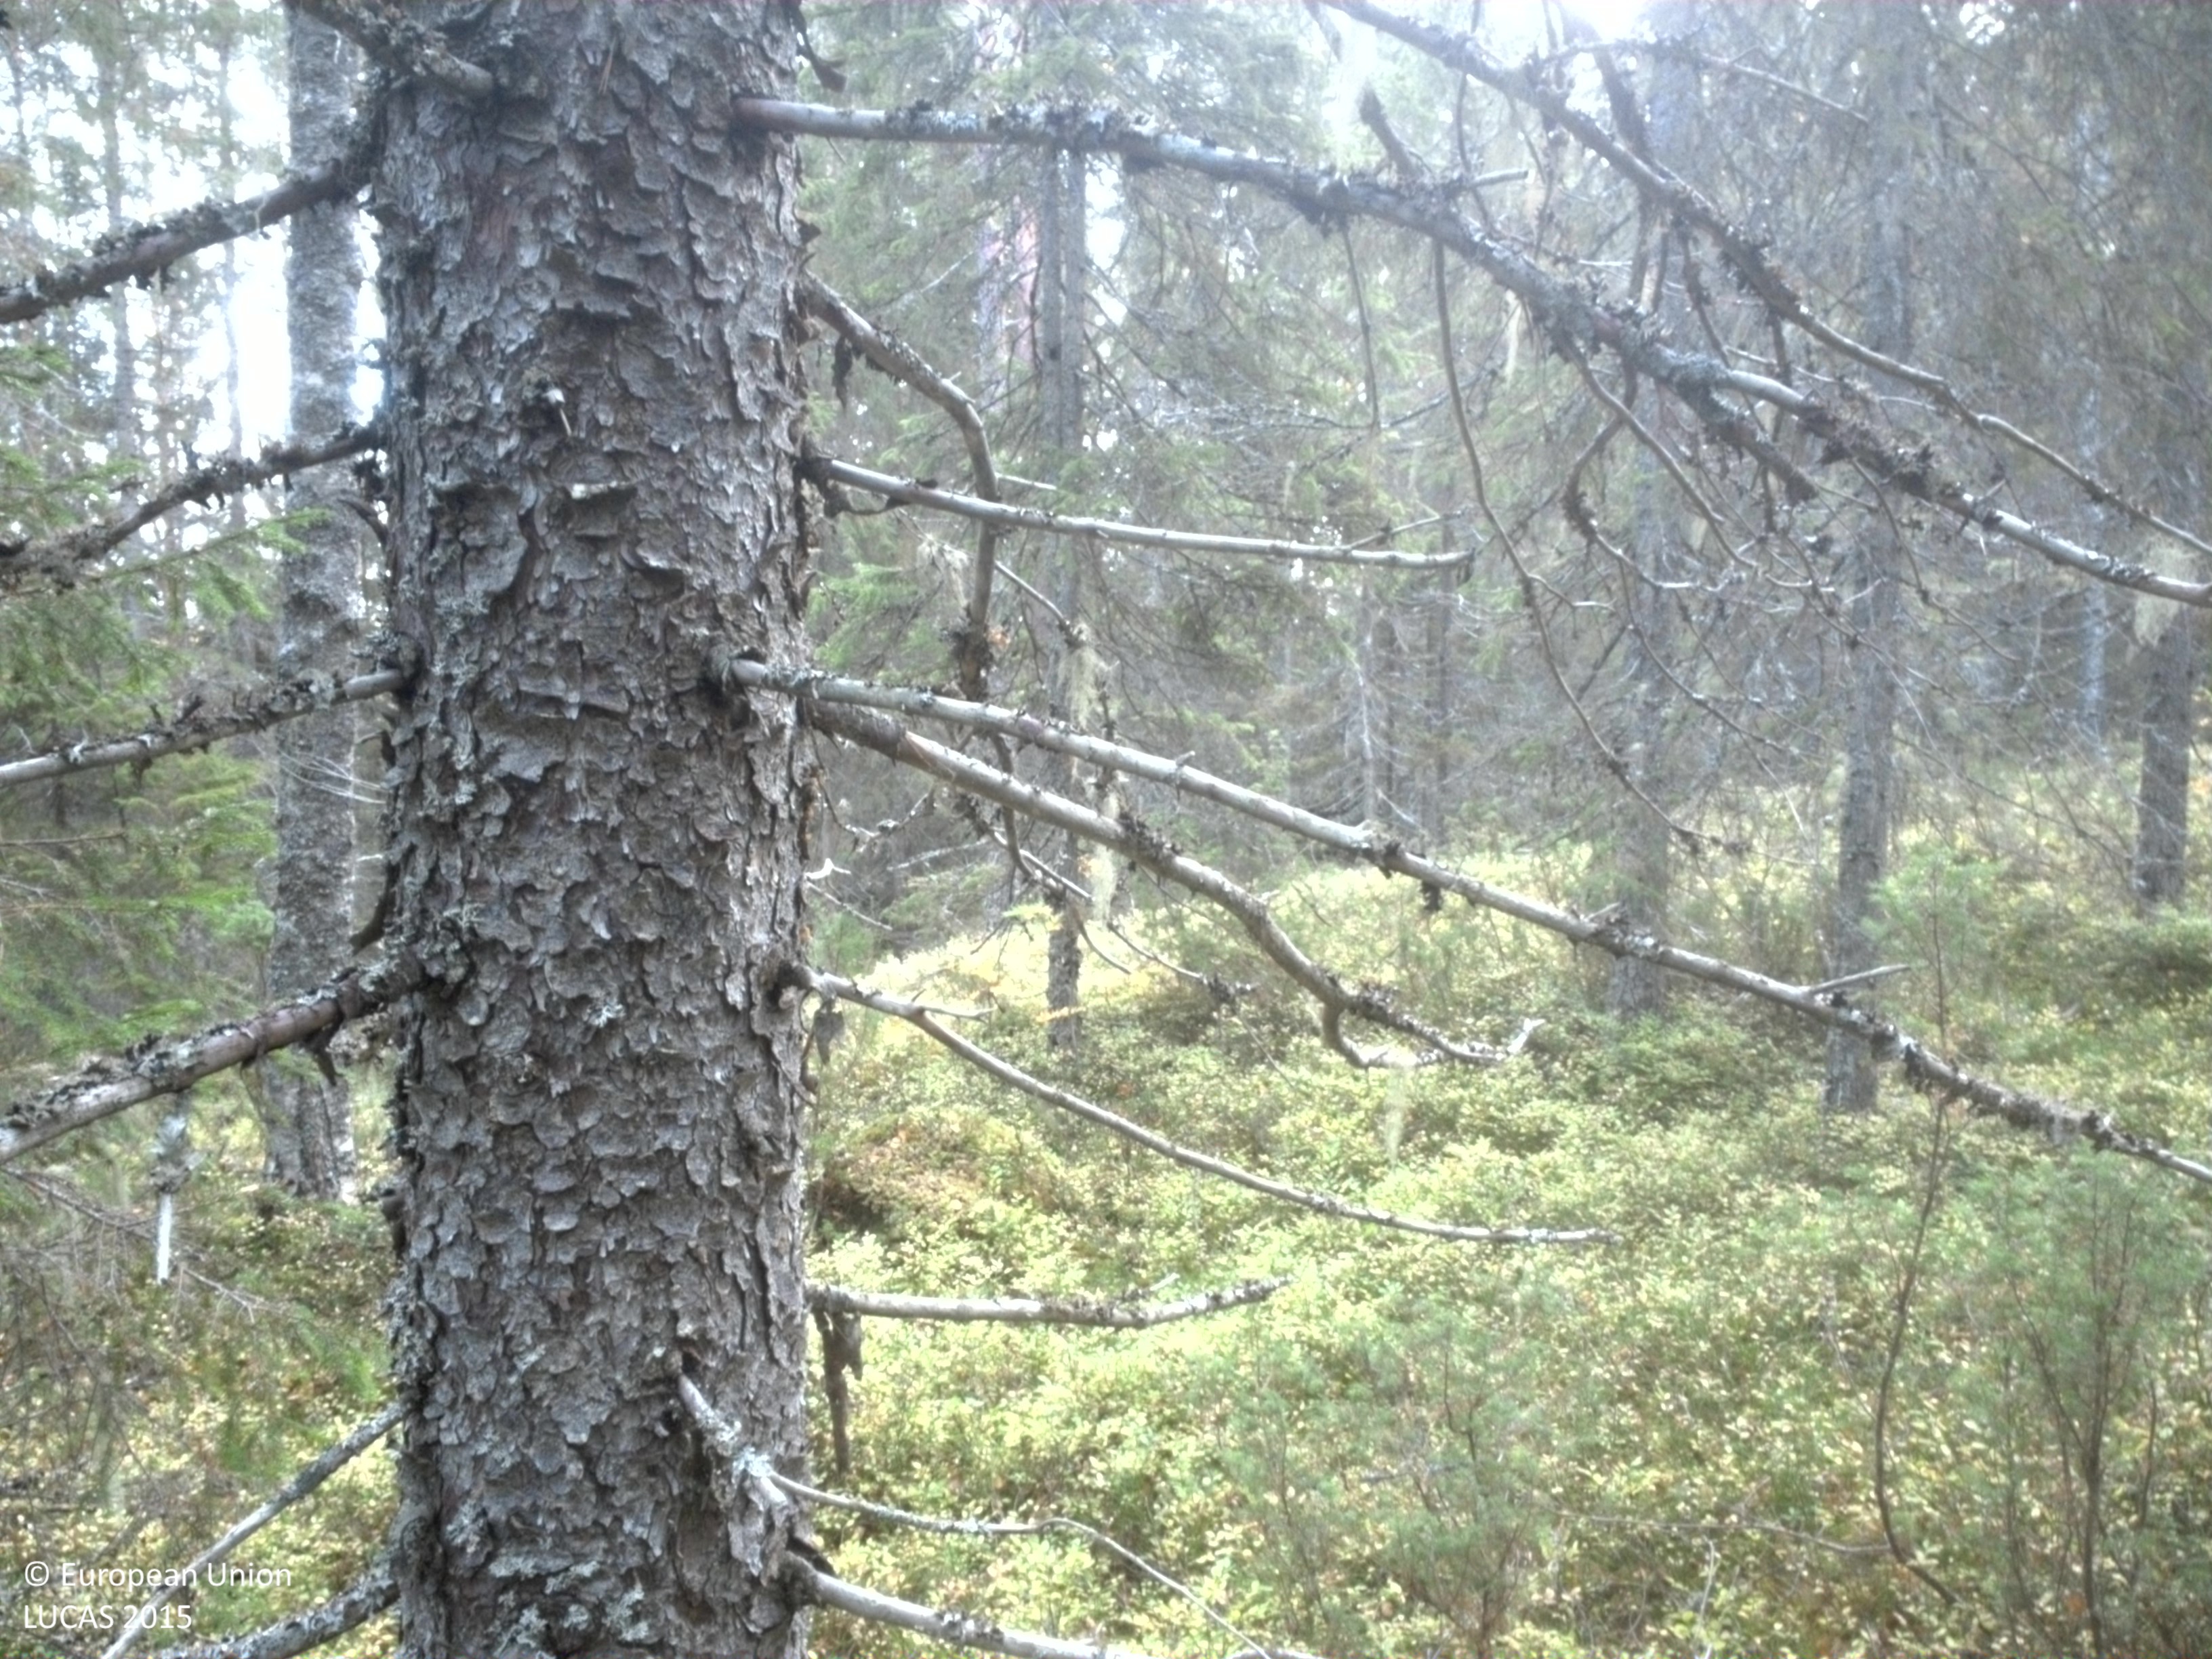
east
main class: Woodland
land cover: Spruce dominated coniferous woodland
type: boreal forest
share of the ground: 50 - 75 %
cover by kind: coniferous forest trees 60 %, shrubs 30 %, broadleaved forest trees 5 %, lichens and mosses 5 %
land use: Forestry
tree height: > 5 m
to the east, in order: Spruce dominated coniferous woodland; Other coniferous woodland; Shrubland with sparse tree cover; Electric lines; Shrubland with sparse tree cover; Spruce dominated mixed woodland; Fences; Ditches and canals; Spruce dominated mixed woodland; Broadleaved woodland; Spruce dominated coniferous woodland; Pine dominated coniferous woodland; Broadleaved woodland; Rivers and streams; Broadleaved woodland; Grassland without tree/shrub cover; Broadleaved woodland; Ditches and canals; Spruce dominated mixed woodland
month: October
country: SE
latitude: 64.0433
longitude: 20.0329
